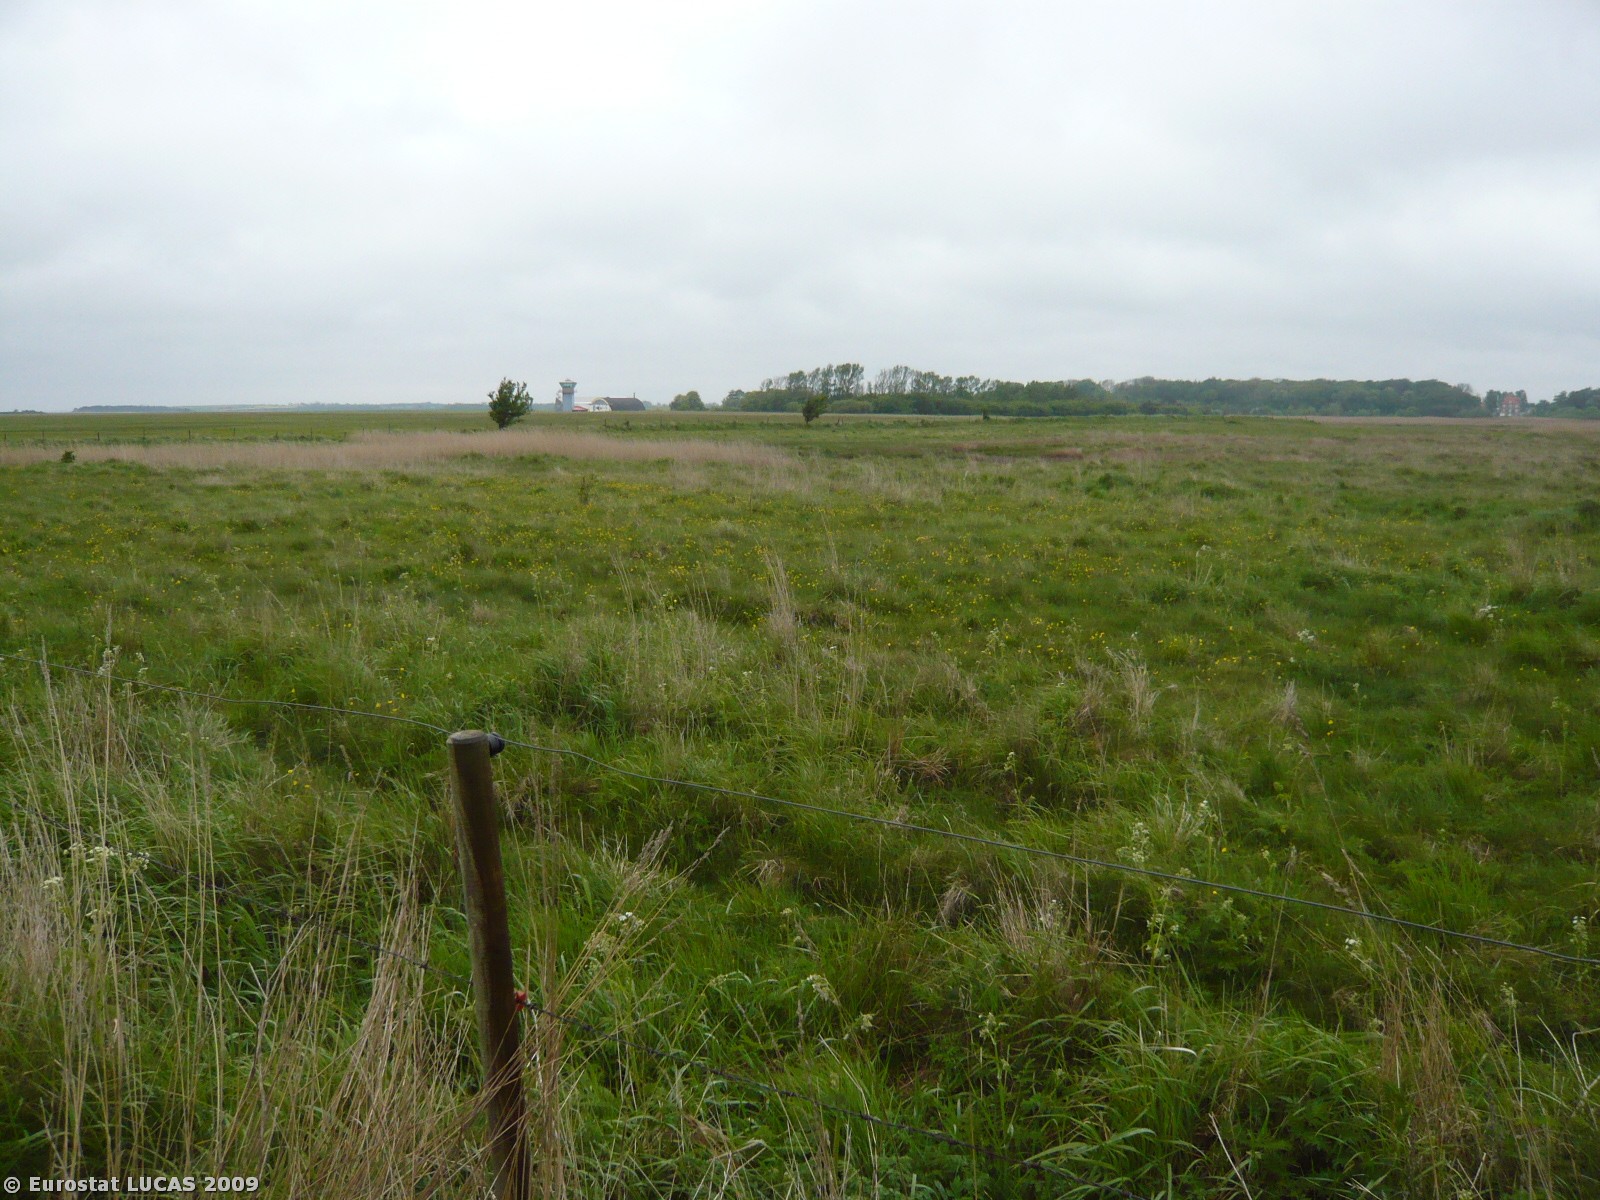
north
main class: Grassland
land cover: Grassland without tree/shrub cover
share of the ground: > 75 %
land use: Agriculture (excluding fallow land and kitchen gardens)
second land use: Nature reserves
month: May
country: DK
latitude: 55.0789
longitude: 11.7687
